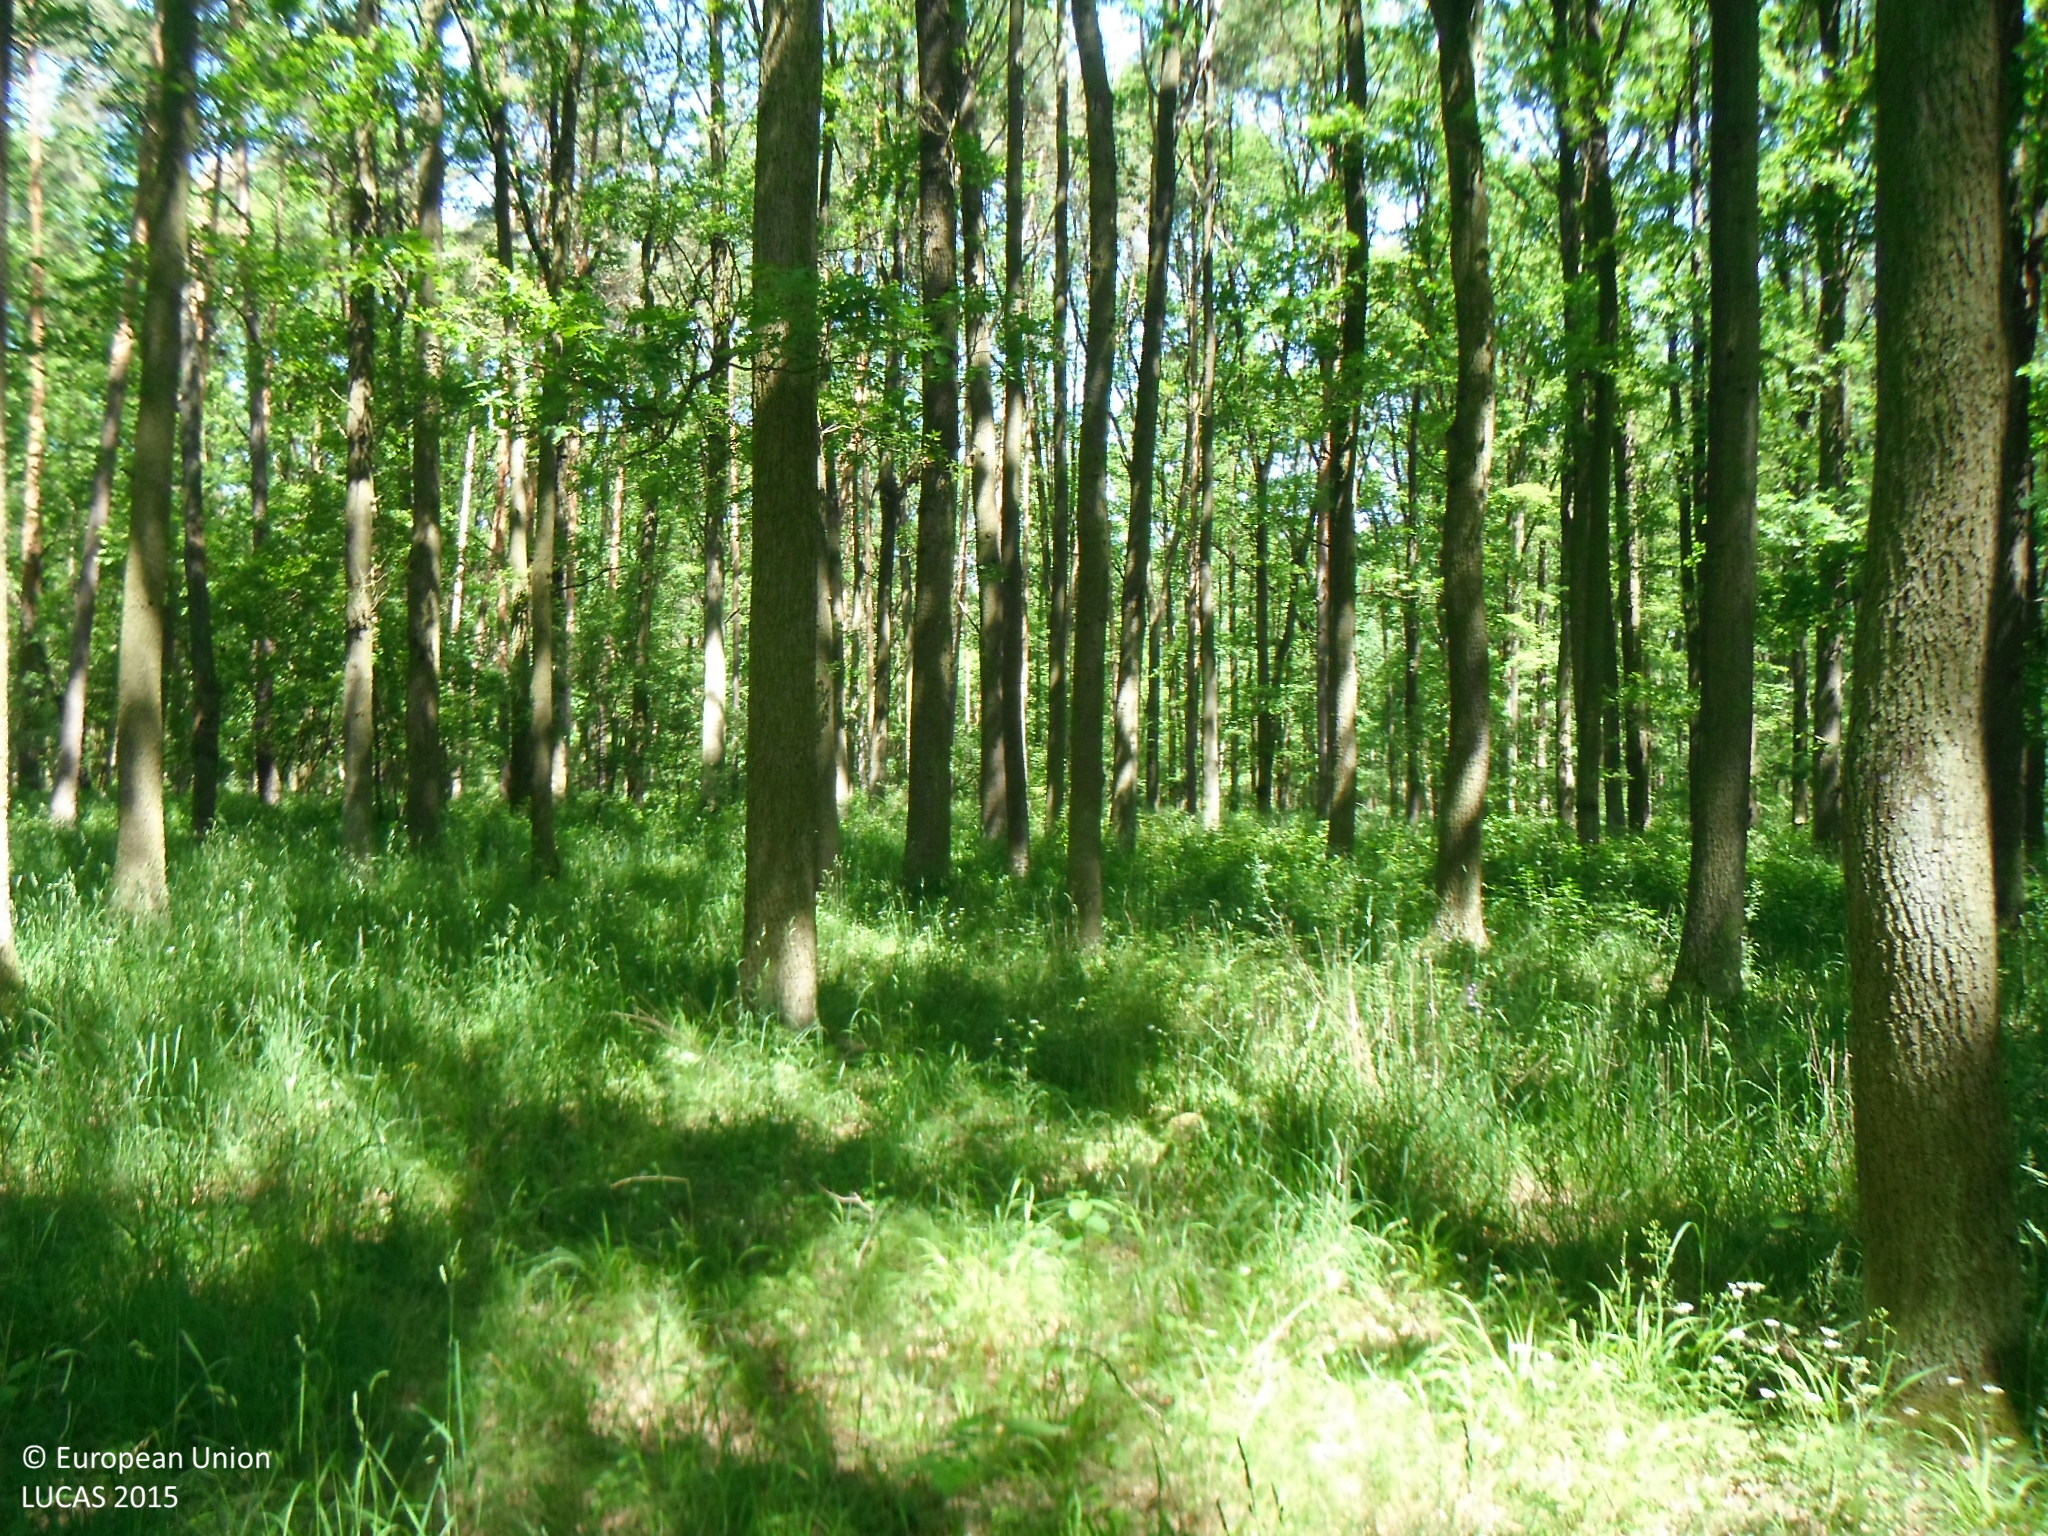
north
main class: Woodland
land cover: Broadleaved woodland
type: mesophytic deciduous forest
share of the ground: > 75 %
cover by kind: broadleaved forest trees 90 %, shrubs 5 %, herbaceous plants 5 %
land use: Forestry
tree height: > 5 m
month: June
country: SK
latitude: 48.7551
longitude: 17.0684
